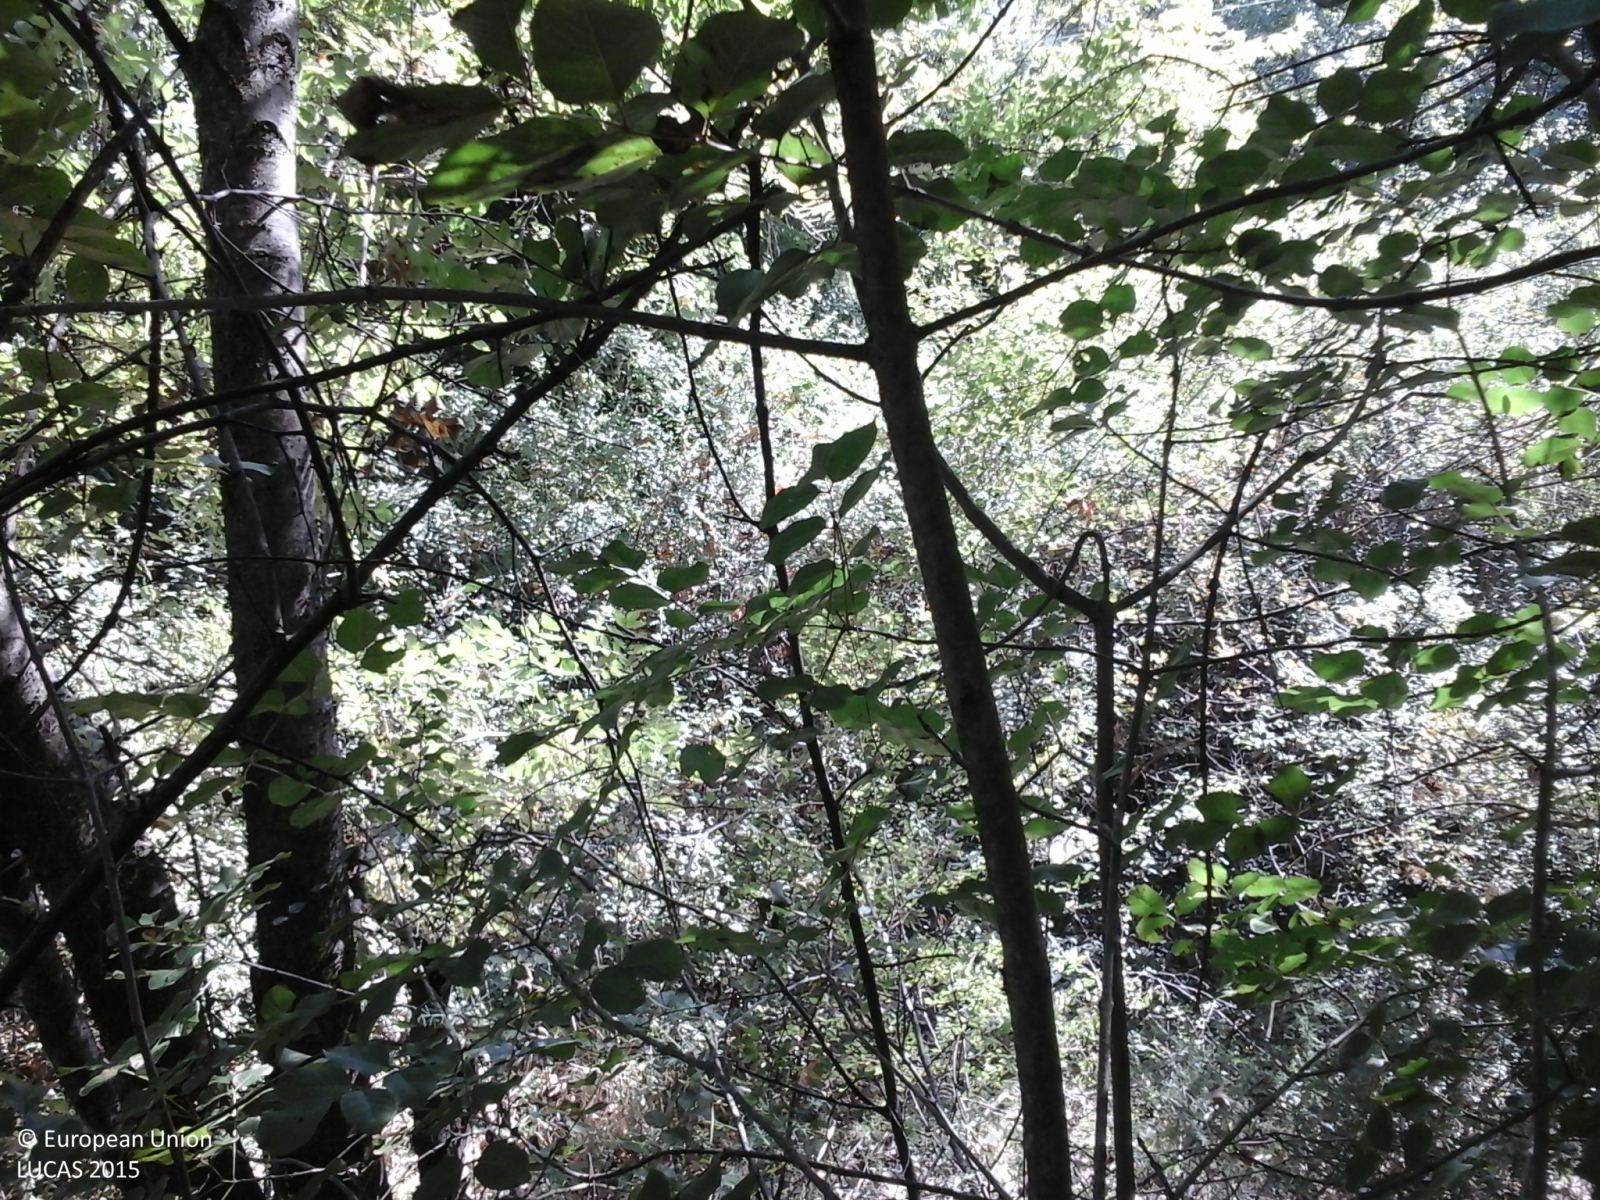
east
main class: Woodland
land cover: Broadleaved woodland
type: thermophilous deciduous forest
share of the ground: 50 - 75 %
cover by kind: broadleaved forest trees 65 %, shrubs 15 %, coniferous forest trees 10 %, herbaceous plants 10 %
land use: Community services
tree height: > 5 m
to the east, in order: Broadleaved woodland; Paved roads, cycling and walking lanes; Broadleaved woodland; Rivers and streams; Broadleaved woodland
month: September
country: GR
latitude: 39.8985
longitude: 20.5406
